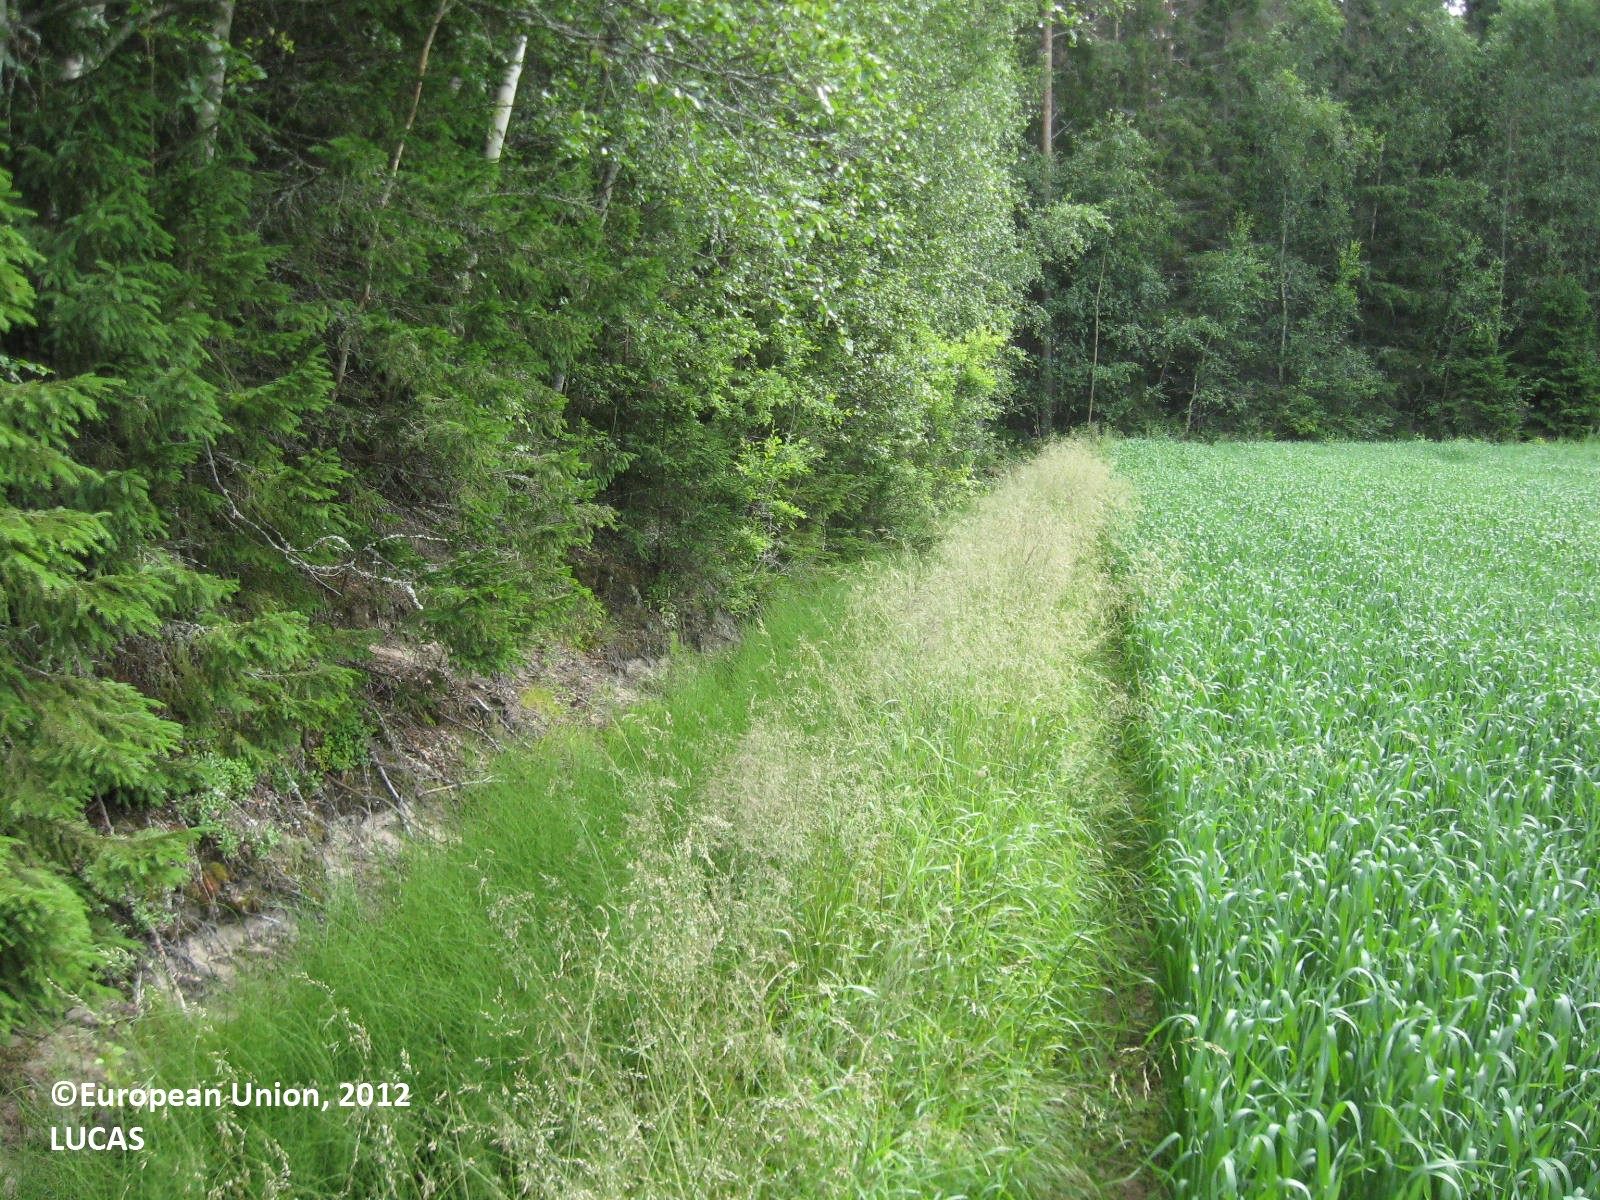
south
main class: Cropland
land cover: Oats
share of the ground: > 75 %
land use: Agriculture (excluding fallow land and kitchen gardens)
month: July
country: FI
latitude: 62.5770
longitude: 21.1917
